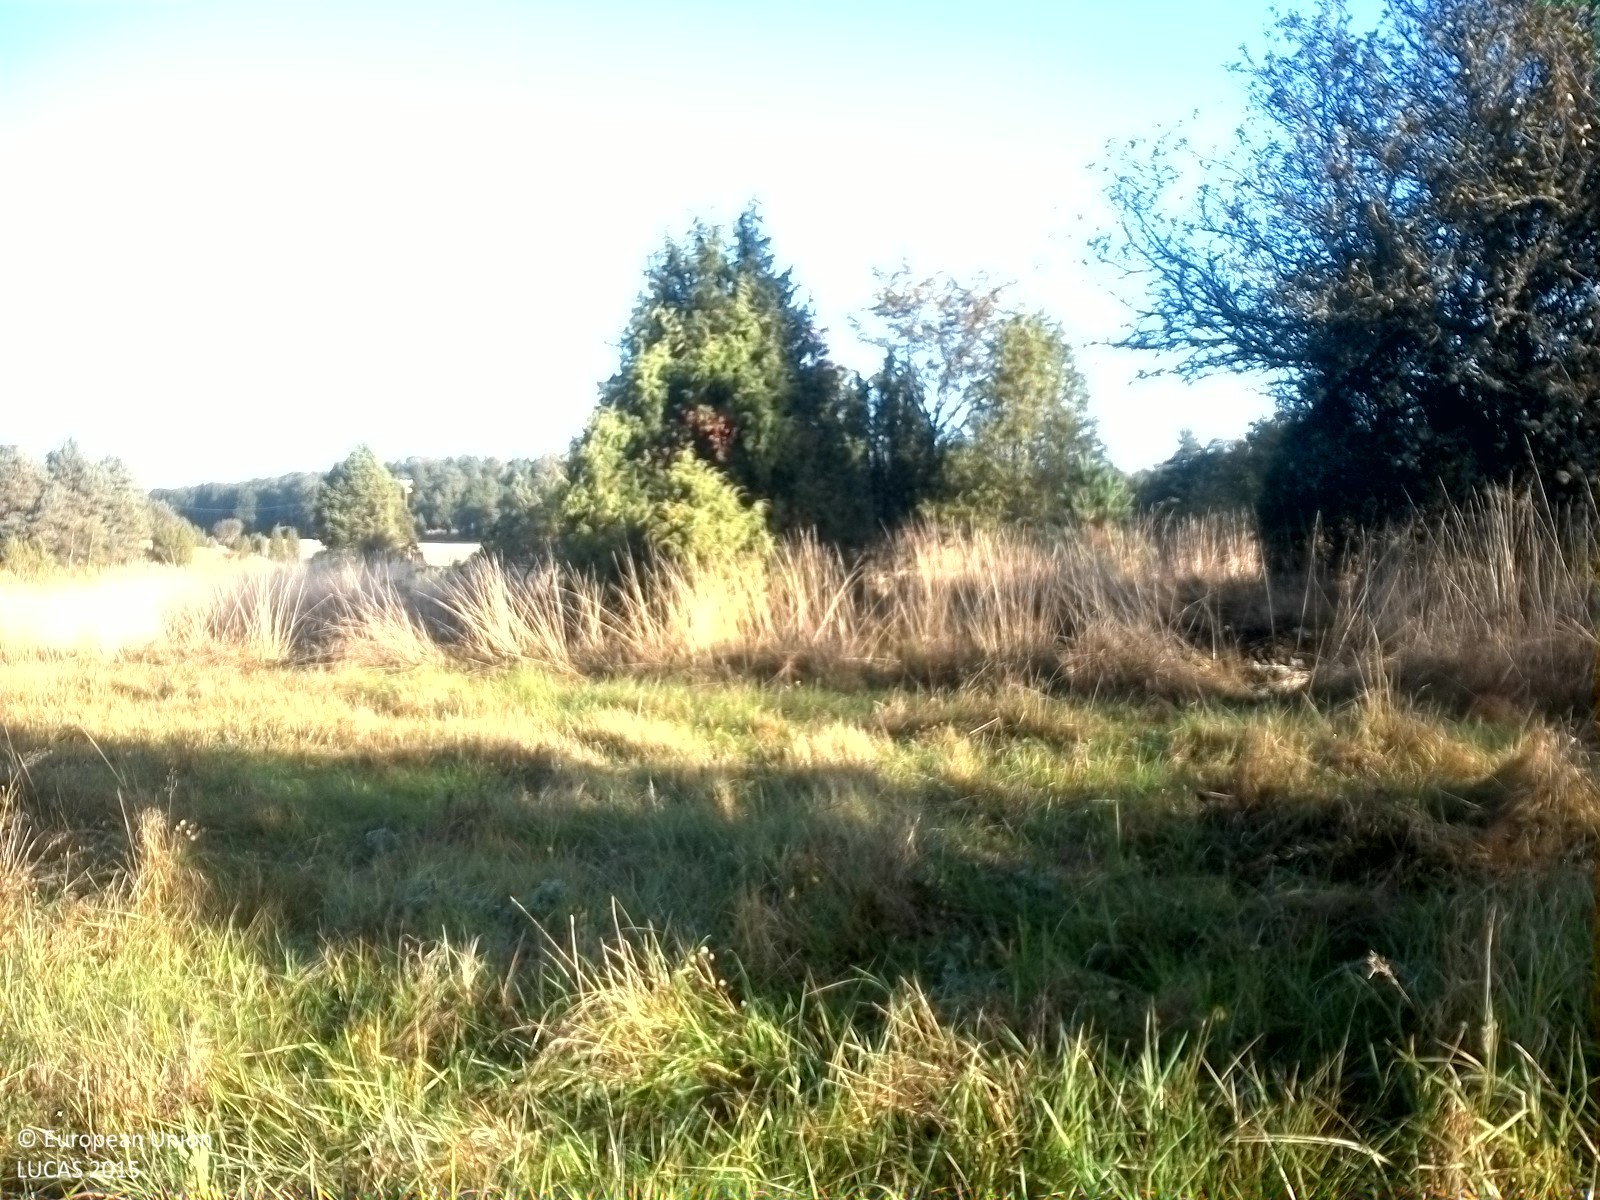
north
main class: Grassland
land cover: Grassland without tree/shrub cover
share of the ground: > 75 %
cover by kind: herbaceous plants 100 %
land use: Agriculture (excluding fallow land and kitchen gardens)
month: September
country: SE
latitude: 58.4840
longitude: 16.7373
